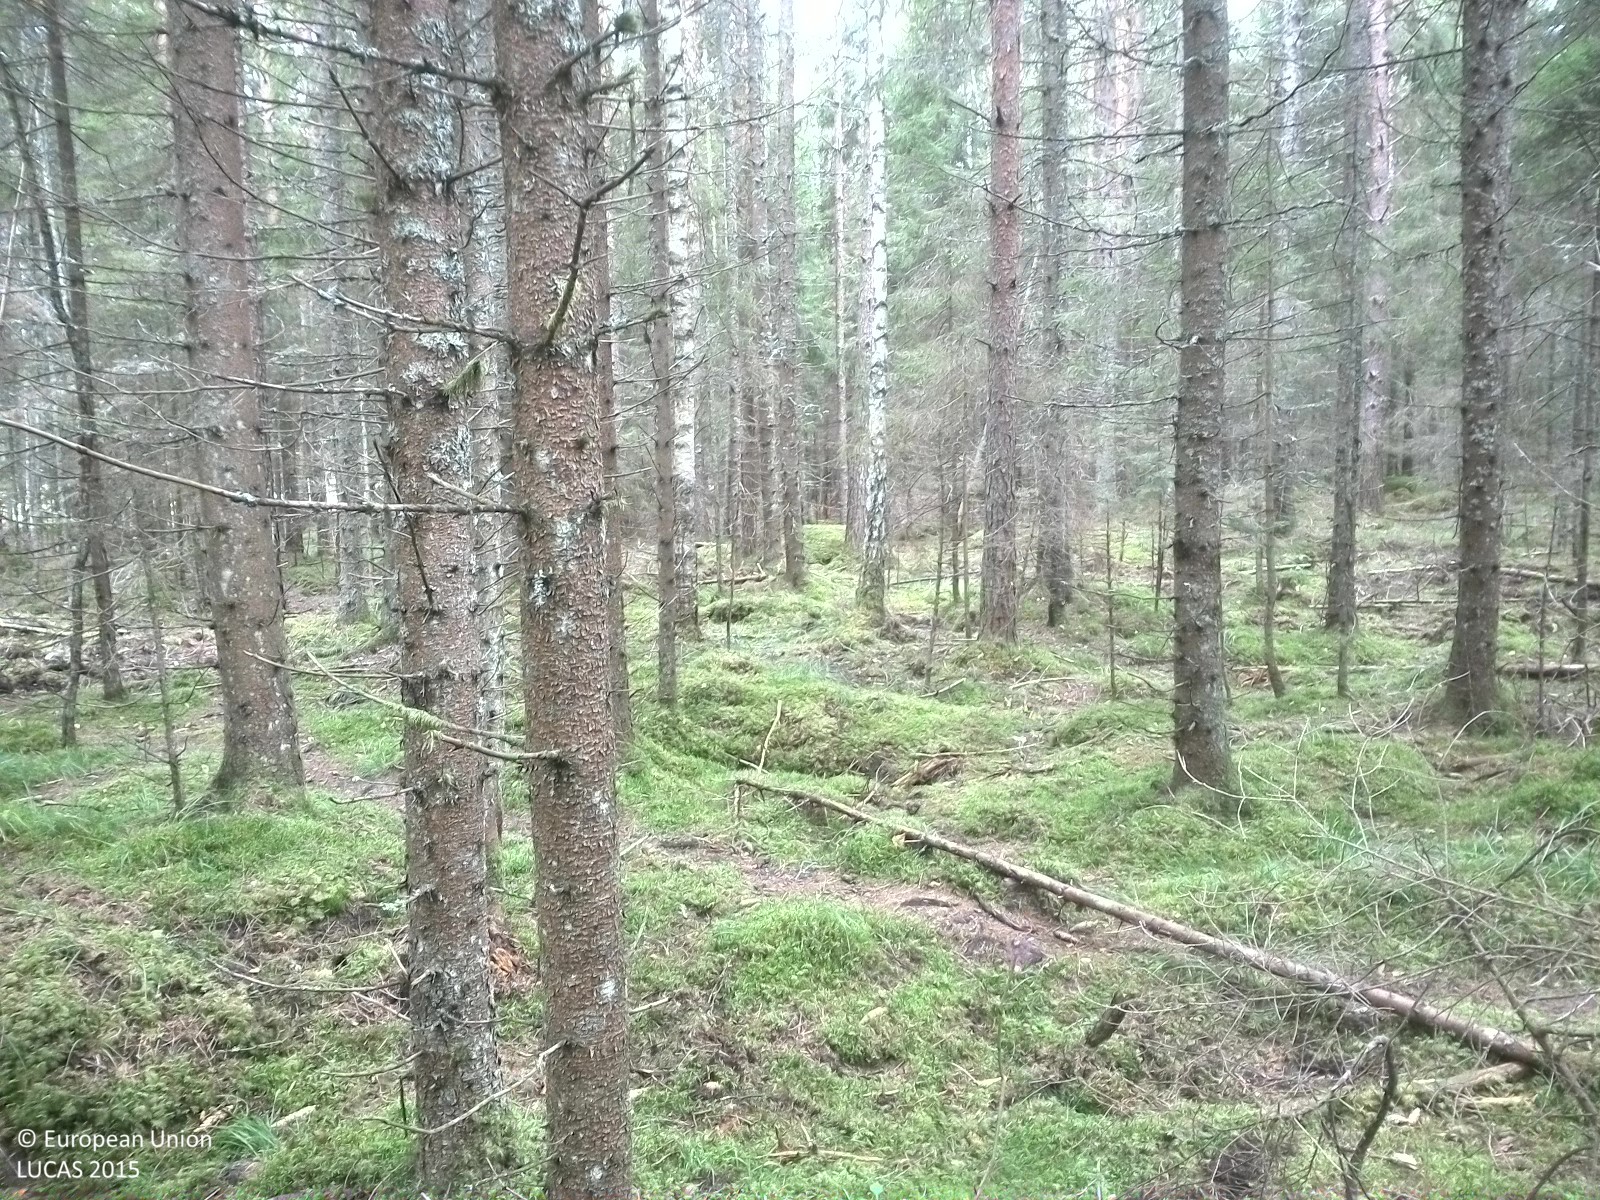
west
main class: Woodland
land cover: Spruce dominated coniferous woodland
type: boreal forest
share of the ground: 50 - 75 %
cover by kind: coniferous forest trees 60 %, lichens and mosses 30 %, herbaceous plants 5 %, unconsolidated bare surface 5 %
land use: Forestry
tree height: > 5 m
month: August
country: SE
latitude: 58.7876
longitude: 15.6163
